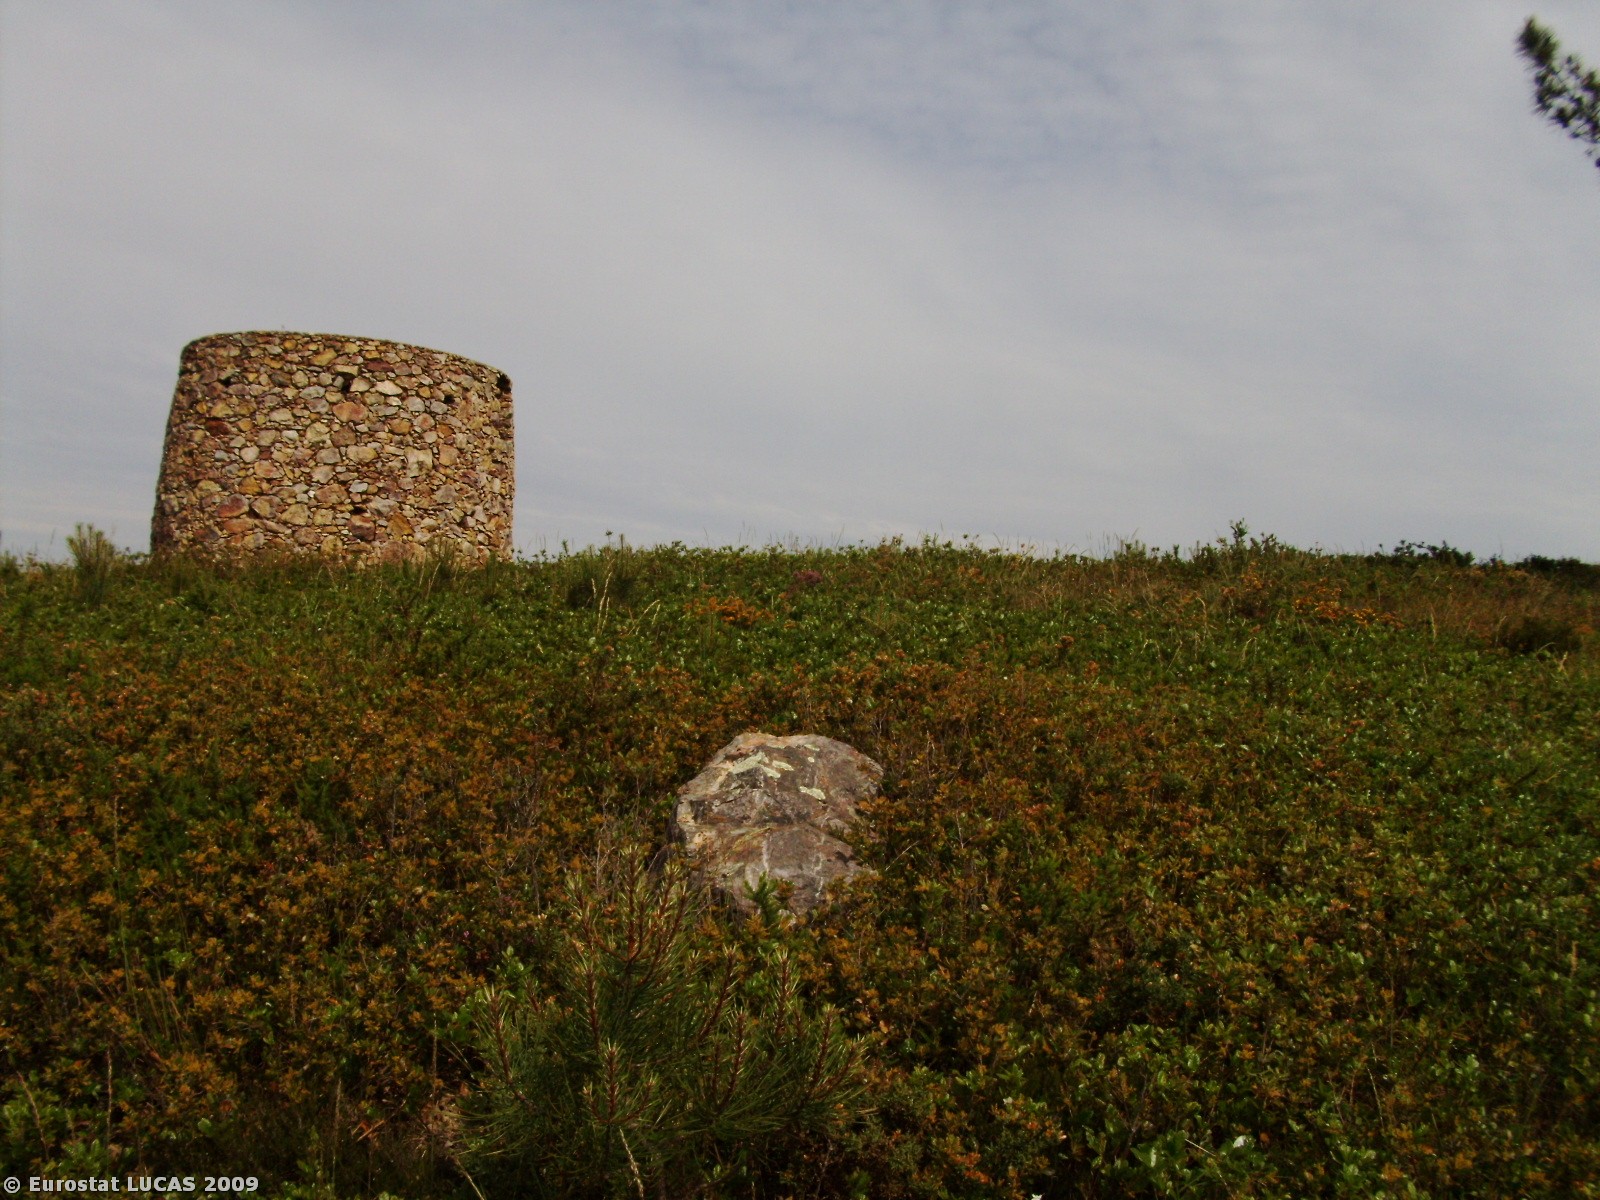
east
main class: Shrubland
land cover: Shrubland without tree cover
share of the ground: > 75 %
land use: Amenities, museums, leisure
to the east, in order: Shrubland without tree cover; Artificial constructions in urban areas; Shrubland without tree cover; Tracks; Shrubland without tree cover; Tracks; Broadleaved woodland
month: May
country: PT
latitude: 40.3033
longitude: -8.3065
